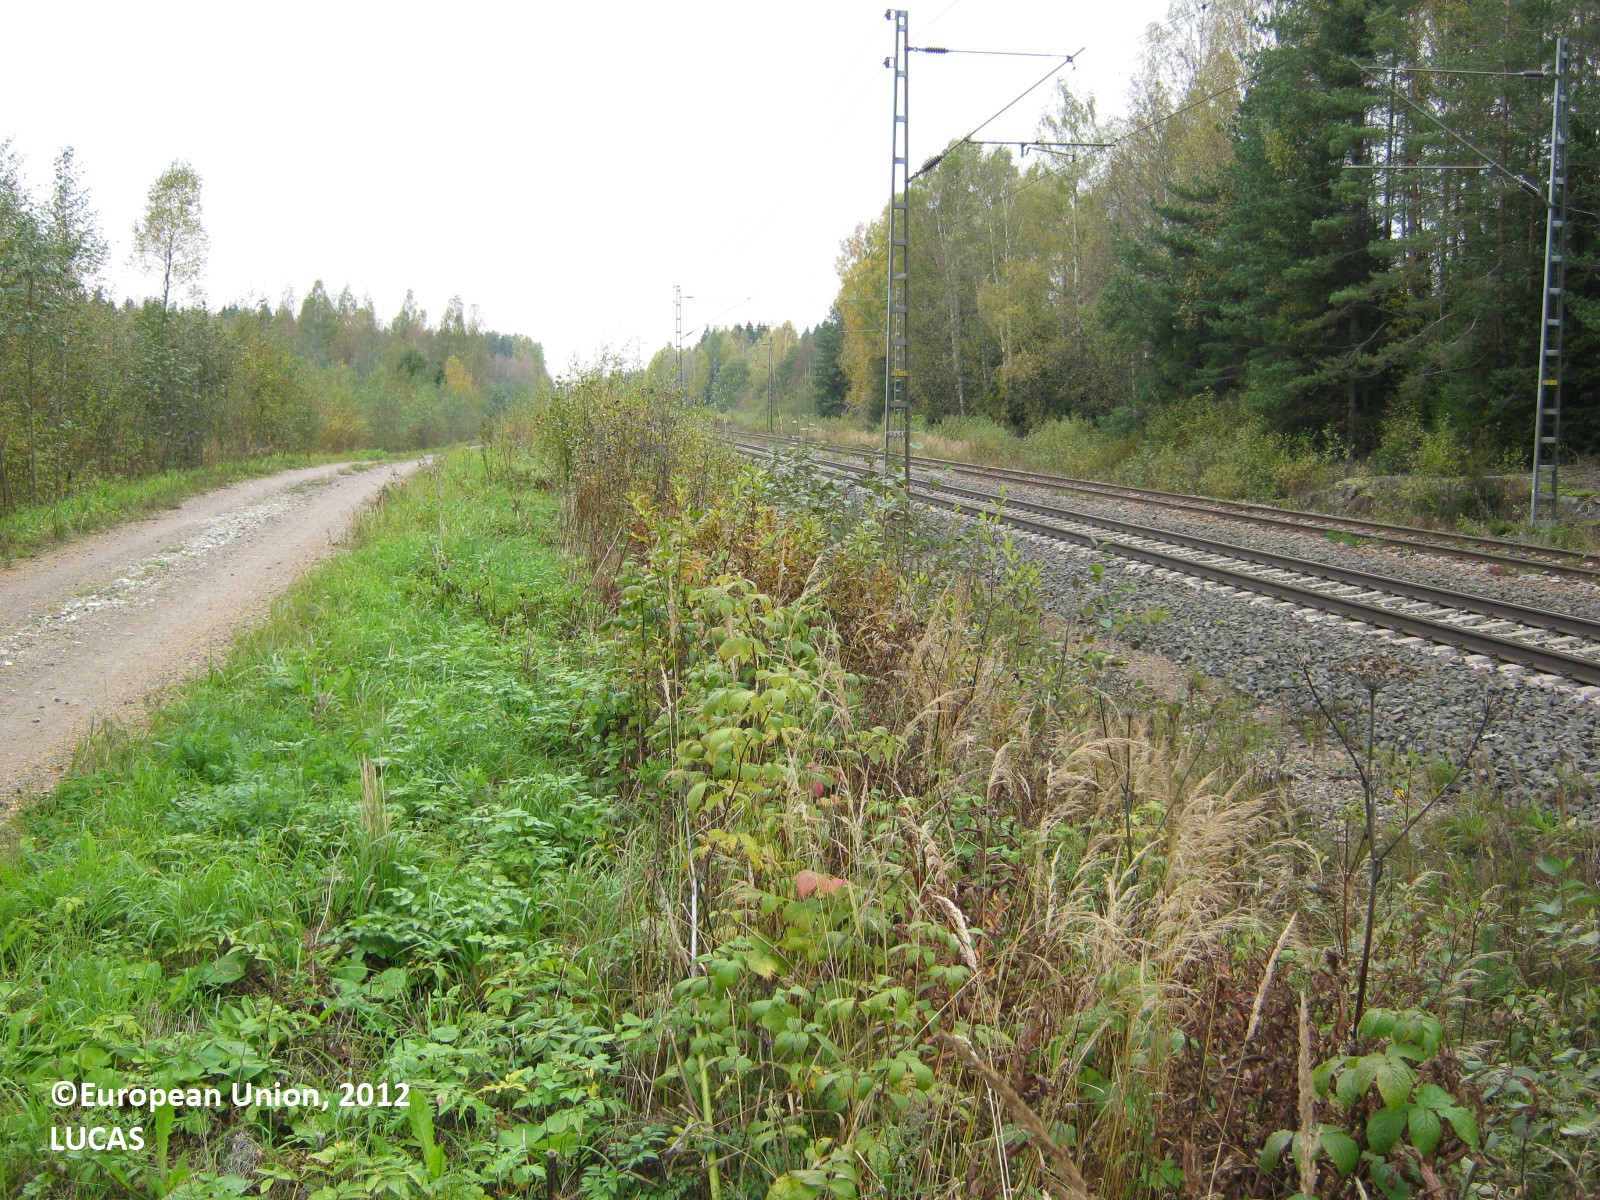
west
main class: Grassland
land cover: Spontaneously vegetated surfaces
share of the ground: > 75 %
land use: Railway transport
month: September
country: FI
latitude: 61.0175
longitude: 28.0925
